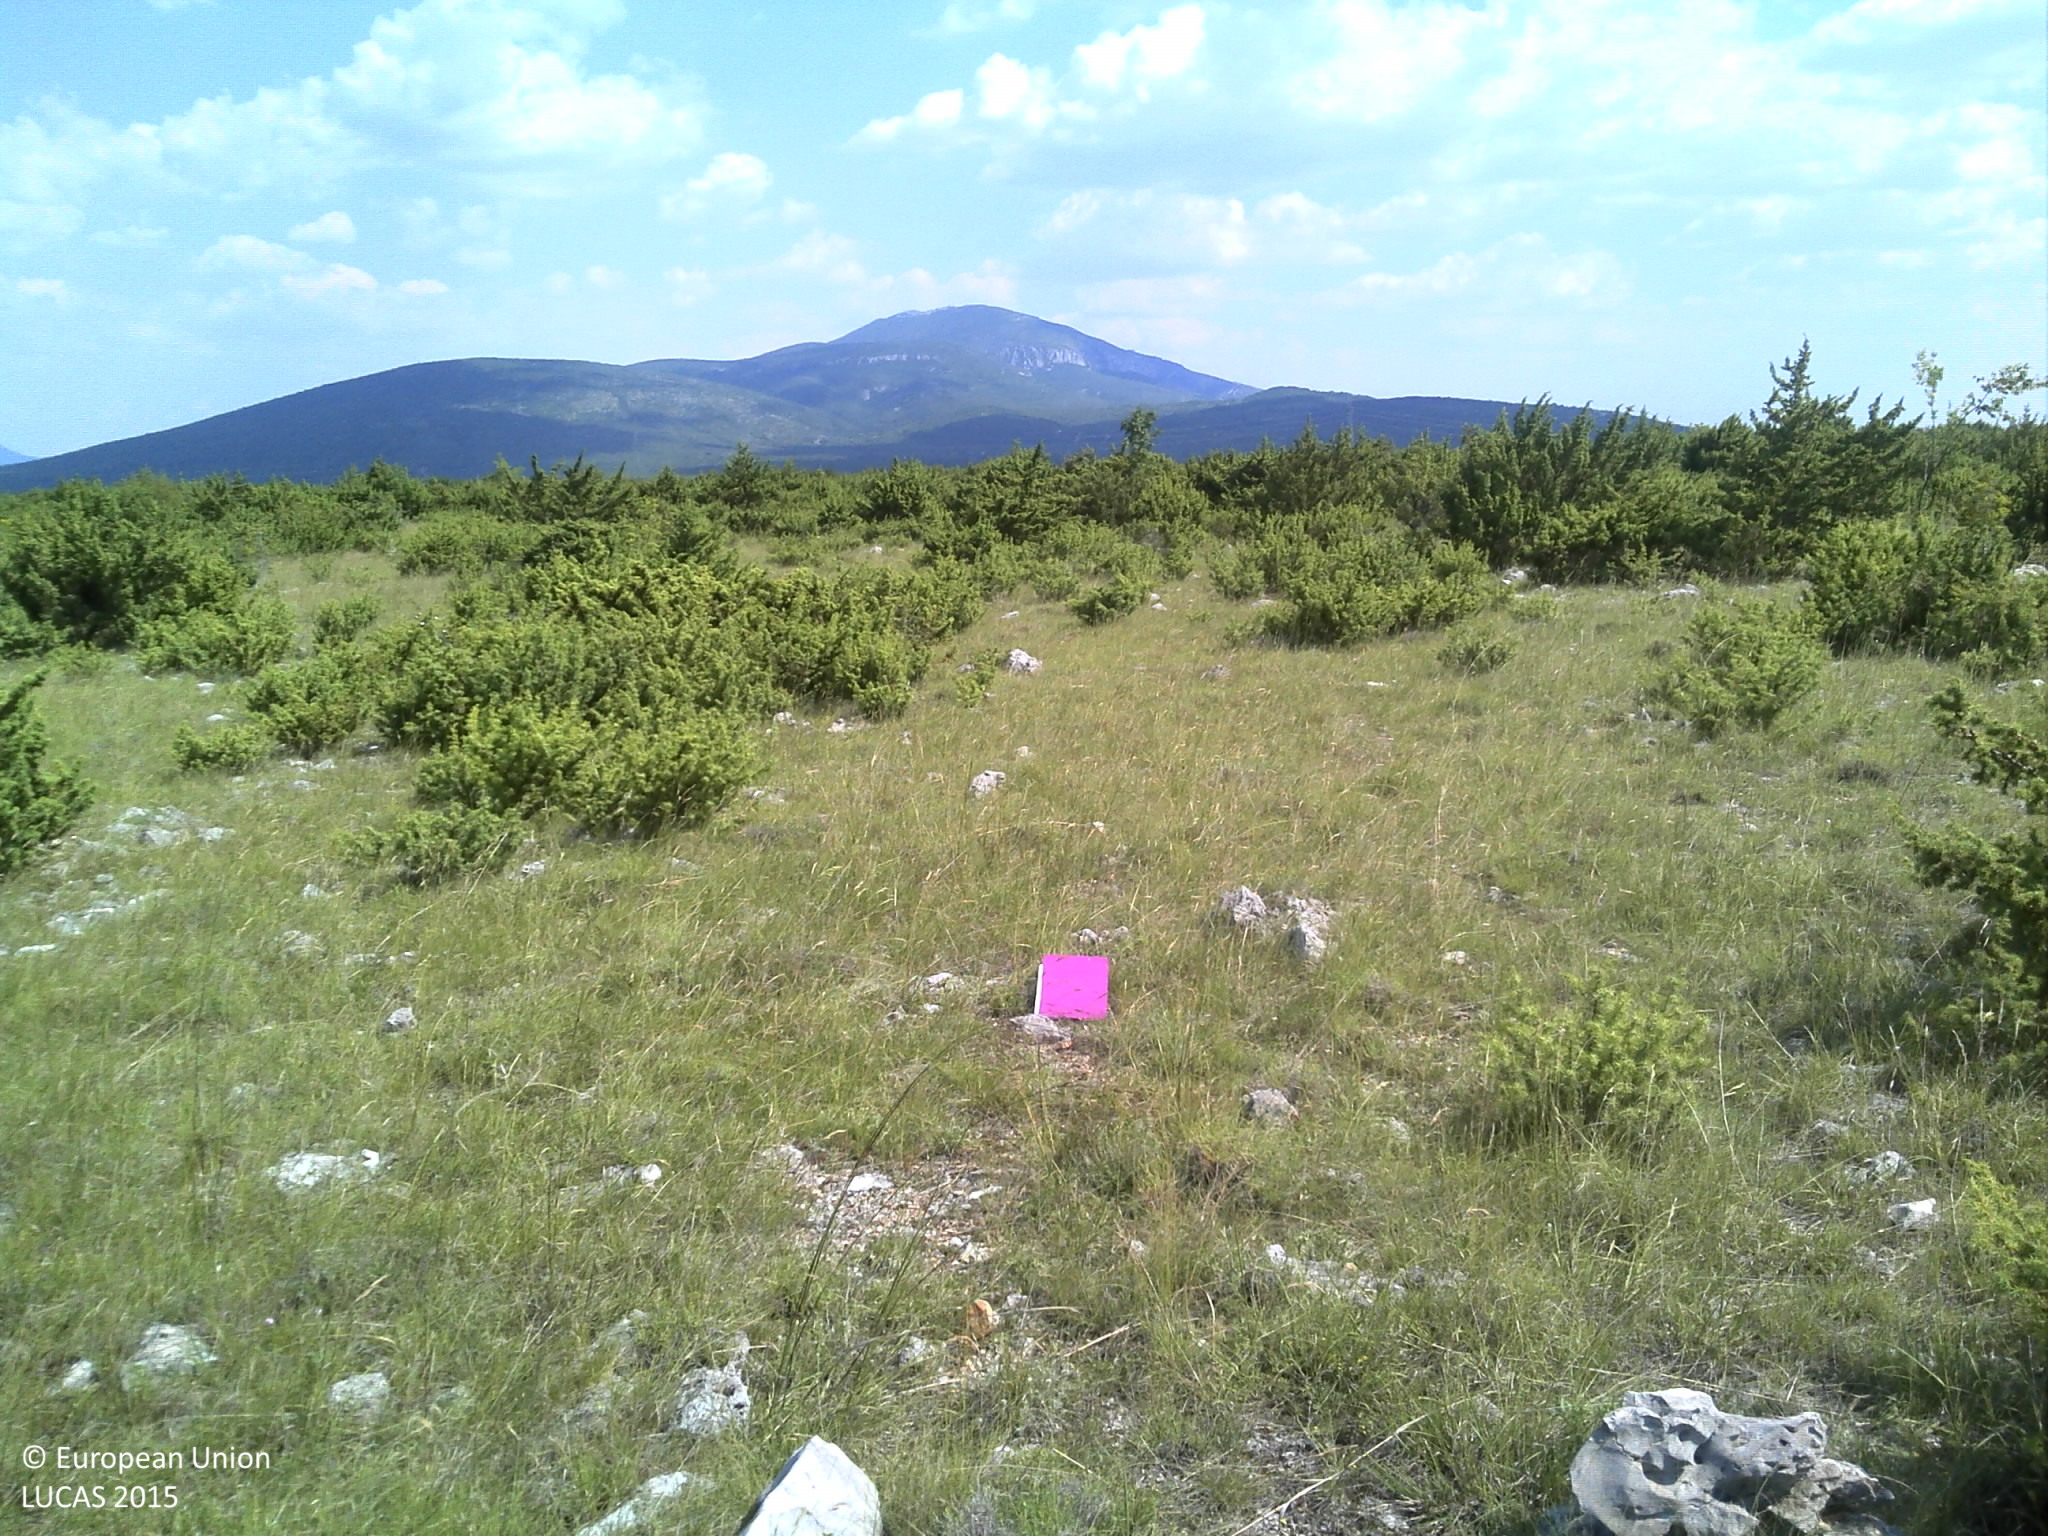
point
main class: Shrubland
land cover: Shrubland with sparse tree cover
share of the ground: 25 - 50 %
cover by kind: herbaceous plants 45 %, shrubs 25 %, unconsolidated bare surface 15 %, consolidated bare surface 10 %, coniferous forest trees 5 %
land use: Semi-natural and natural areas not in use
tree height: < 5 m
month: June
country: HR
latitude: 43.9908
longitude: 16.0895
